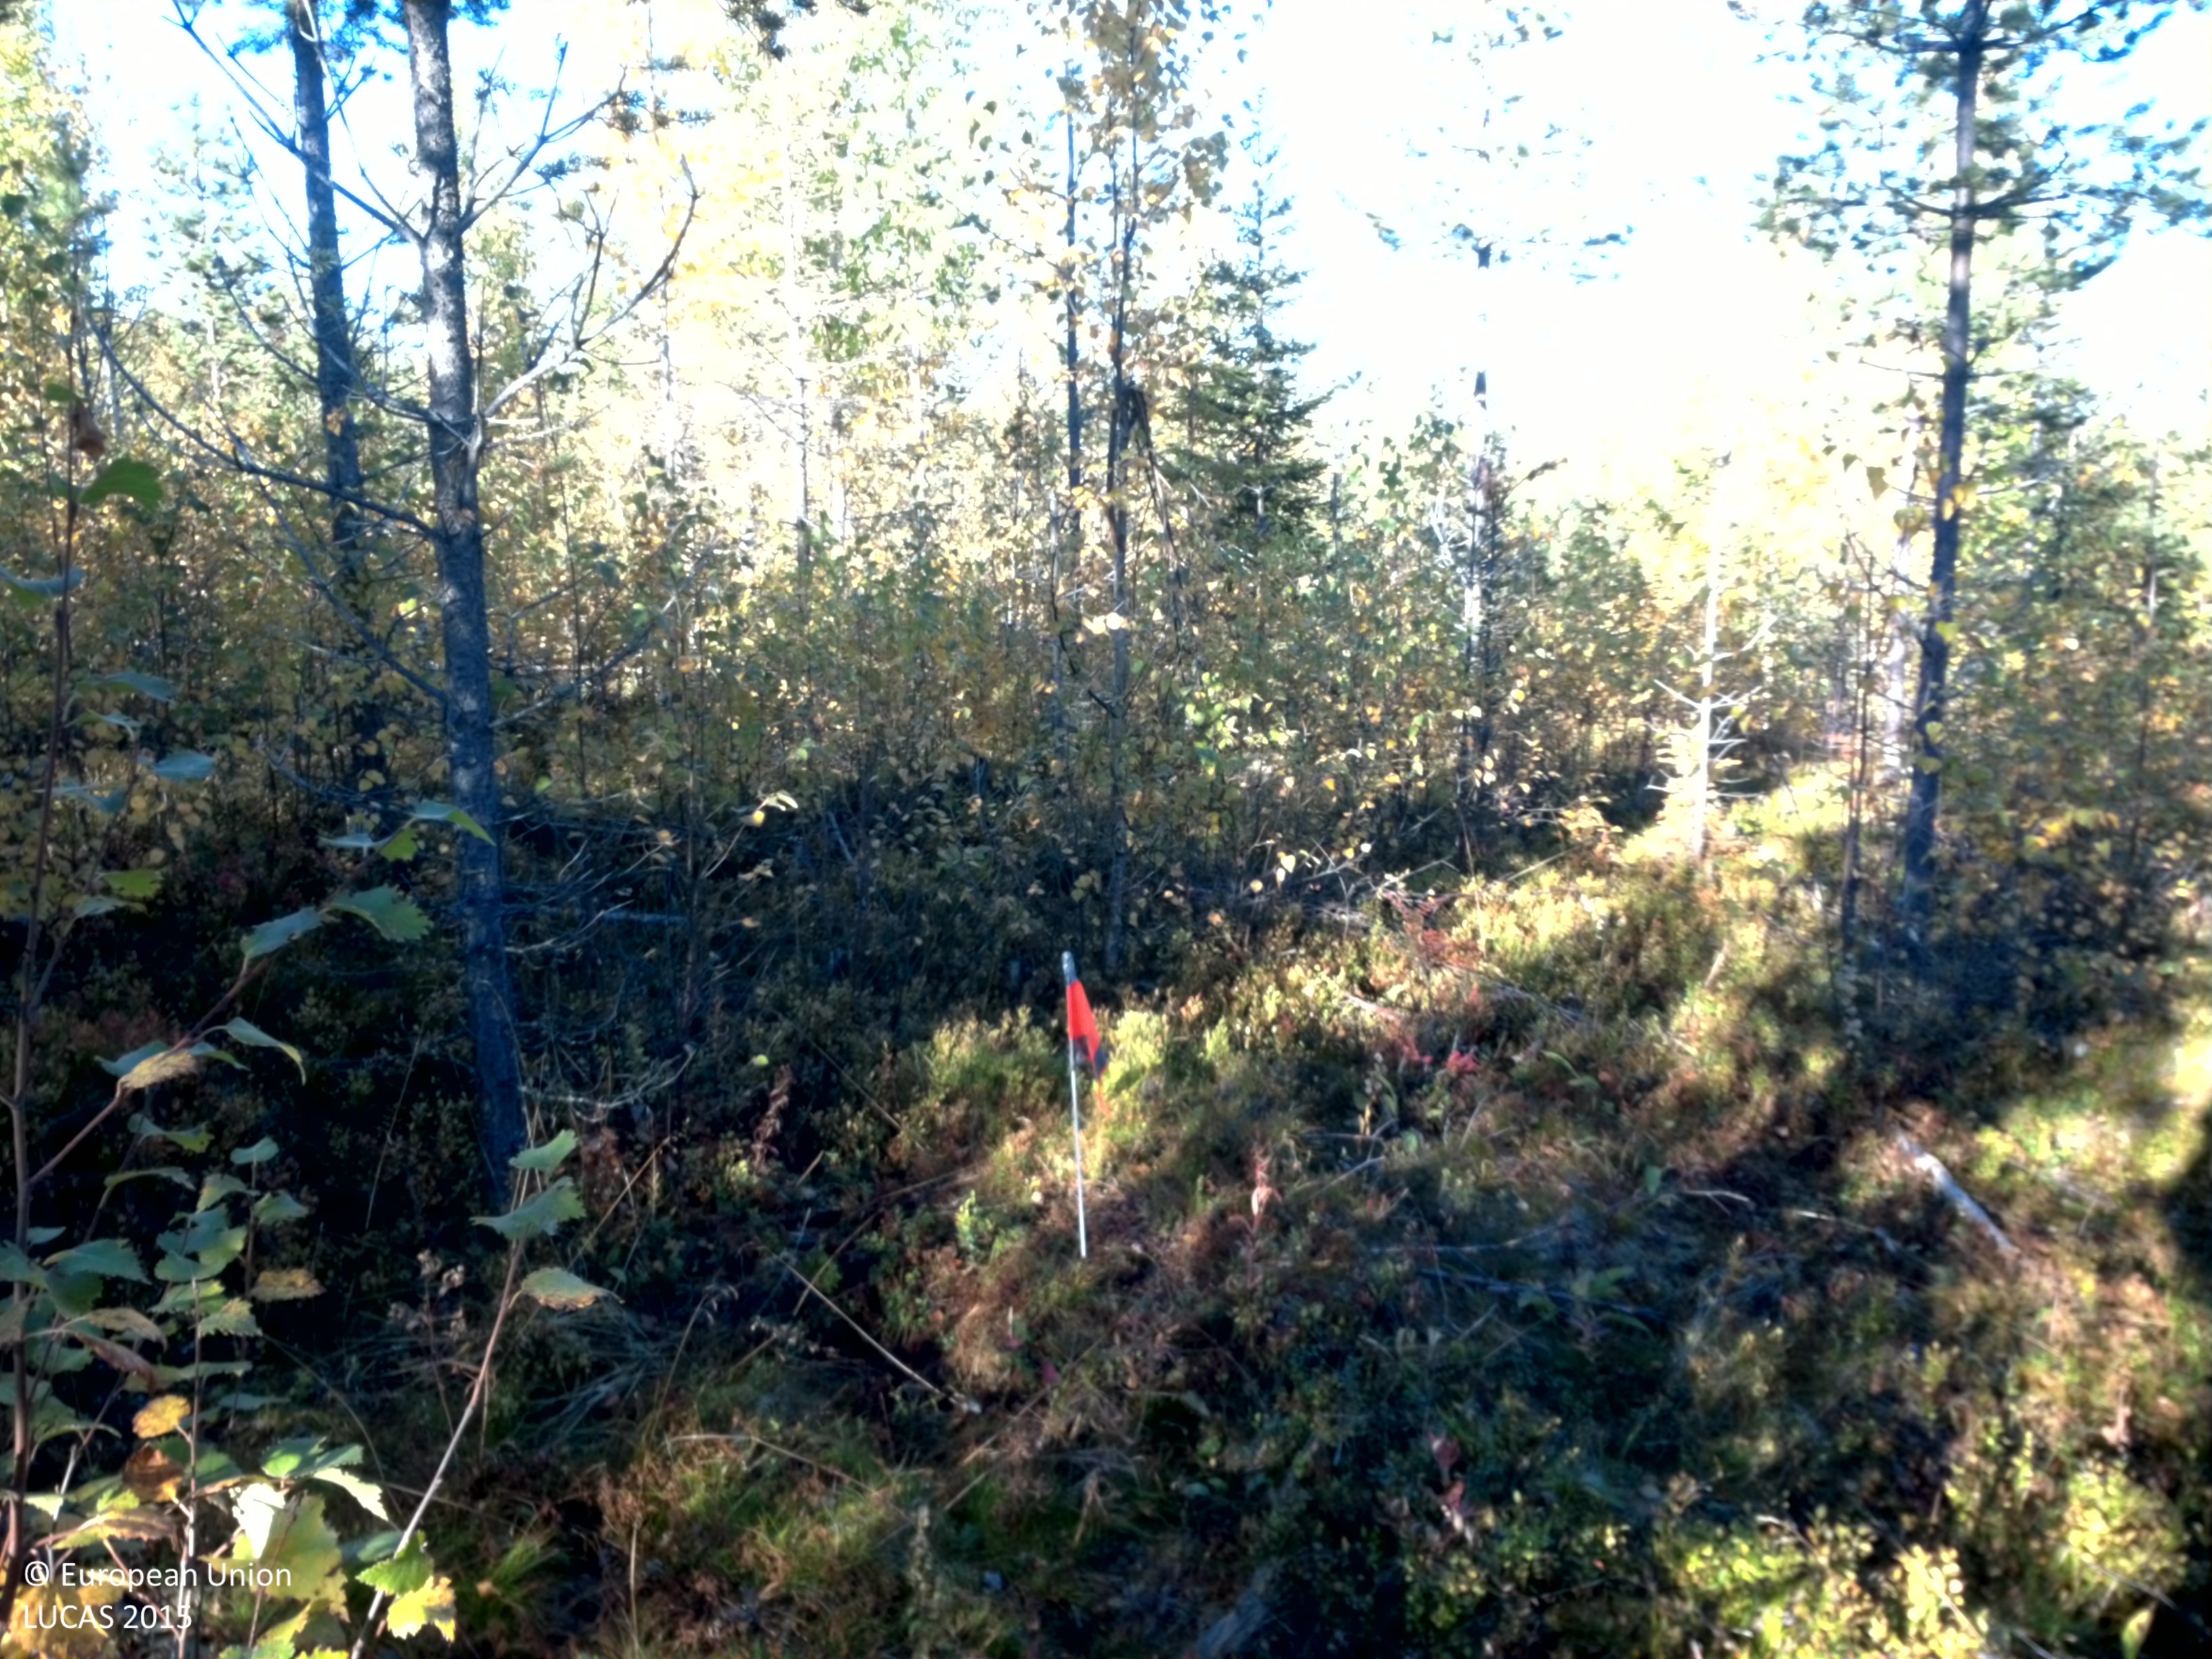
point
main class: Woodland
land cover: Pine dominated mixed woodland
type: boreal forest
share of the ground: 25 - 50 %
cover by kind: shrubs 45 %, herbaceous plants 20 %, coniferous forest trees 15 %, broadleaved forest trees 15 %, lichens and mosses 5 %
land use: Forestry
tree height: > 5 m
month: September
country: SE
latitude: 64.8943
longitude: 17.8434
